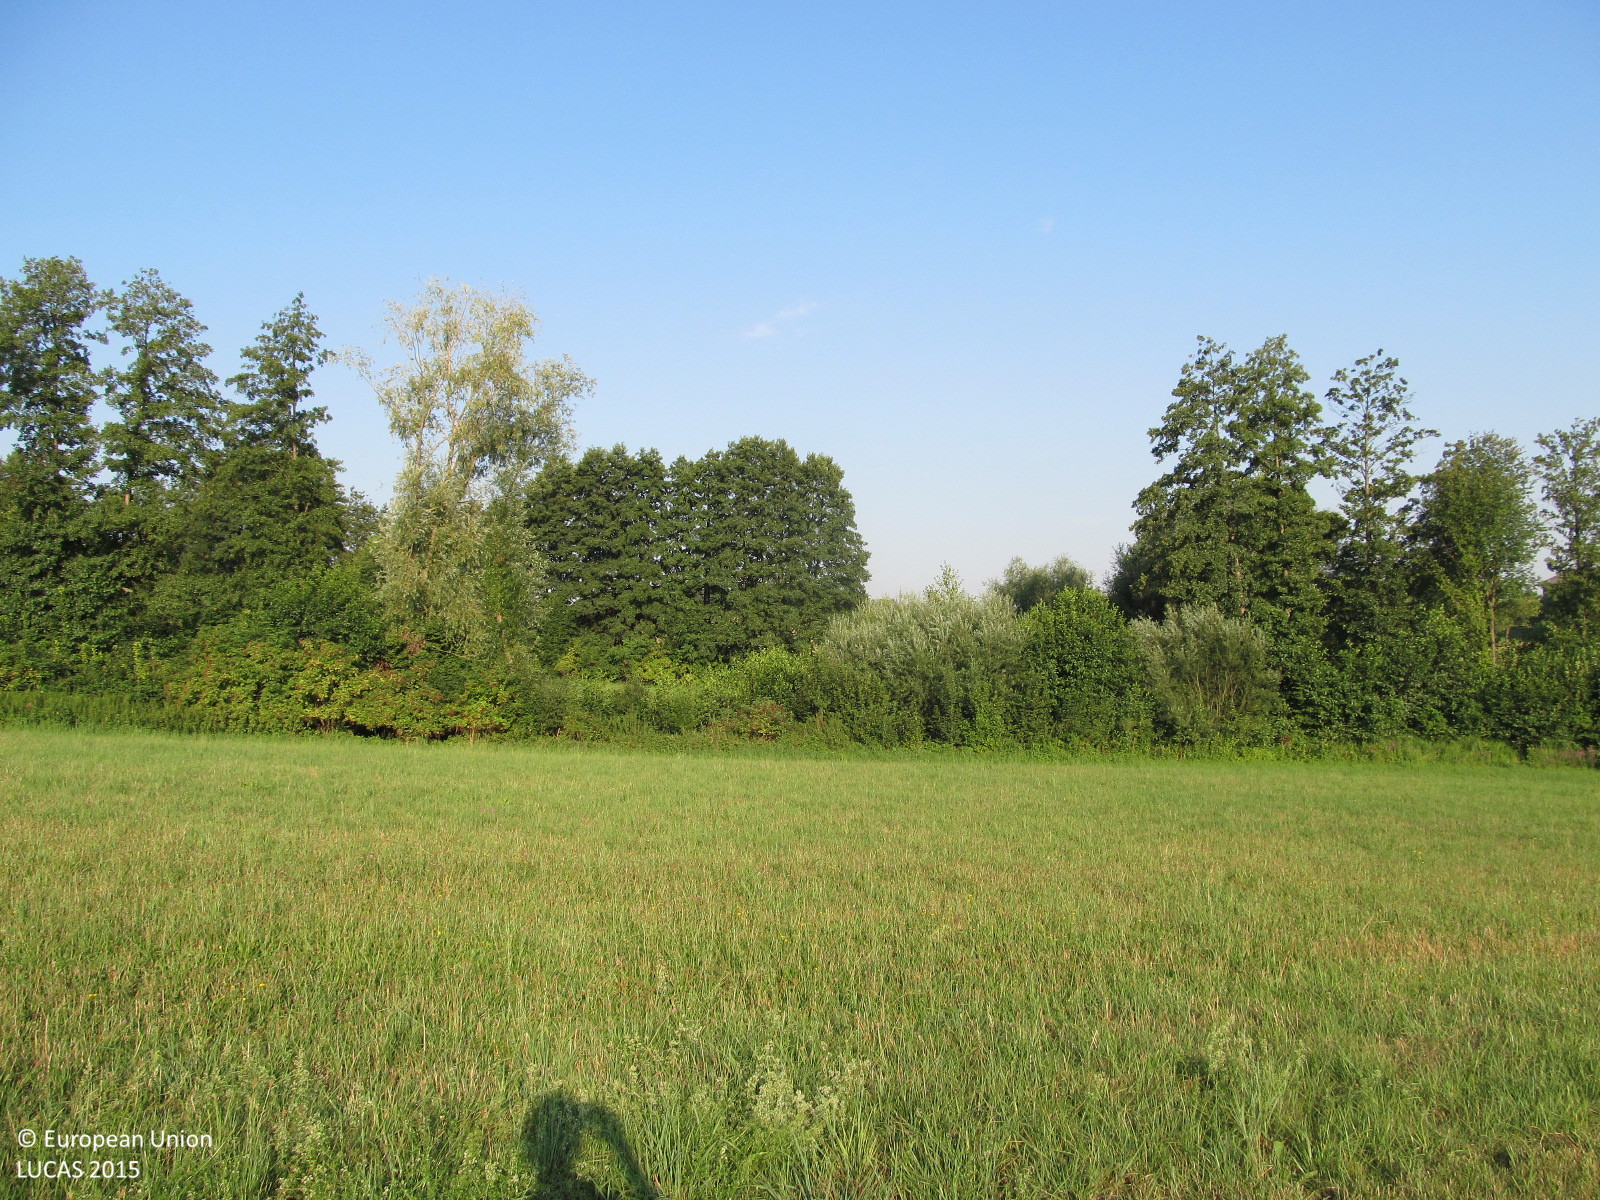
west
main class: Grassland
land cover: Grassland without tree/shrub cover
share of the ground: > 75 %
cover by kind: herbaceous plants 100 %
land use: Agriculture (excluding fallow land and kitchen gardens)
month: August
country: AT
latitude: 48.1072
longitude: 15.4413
